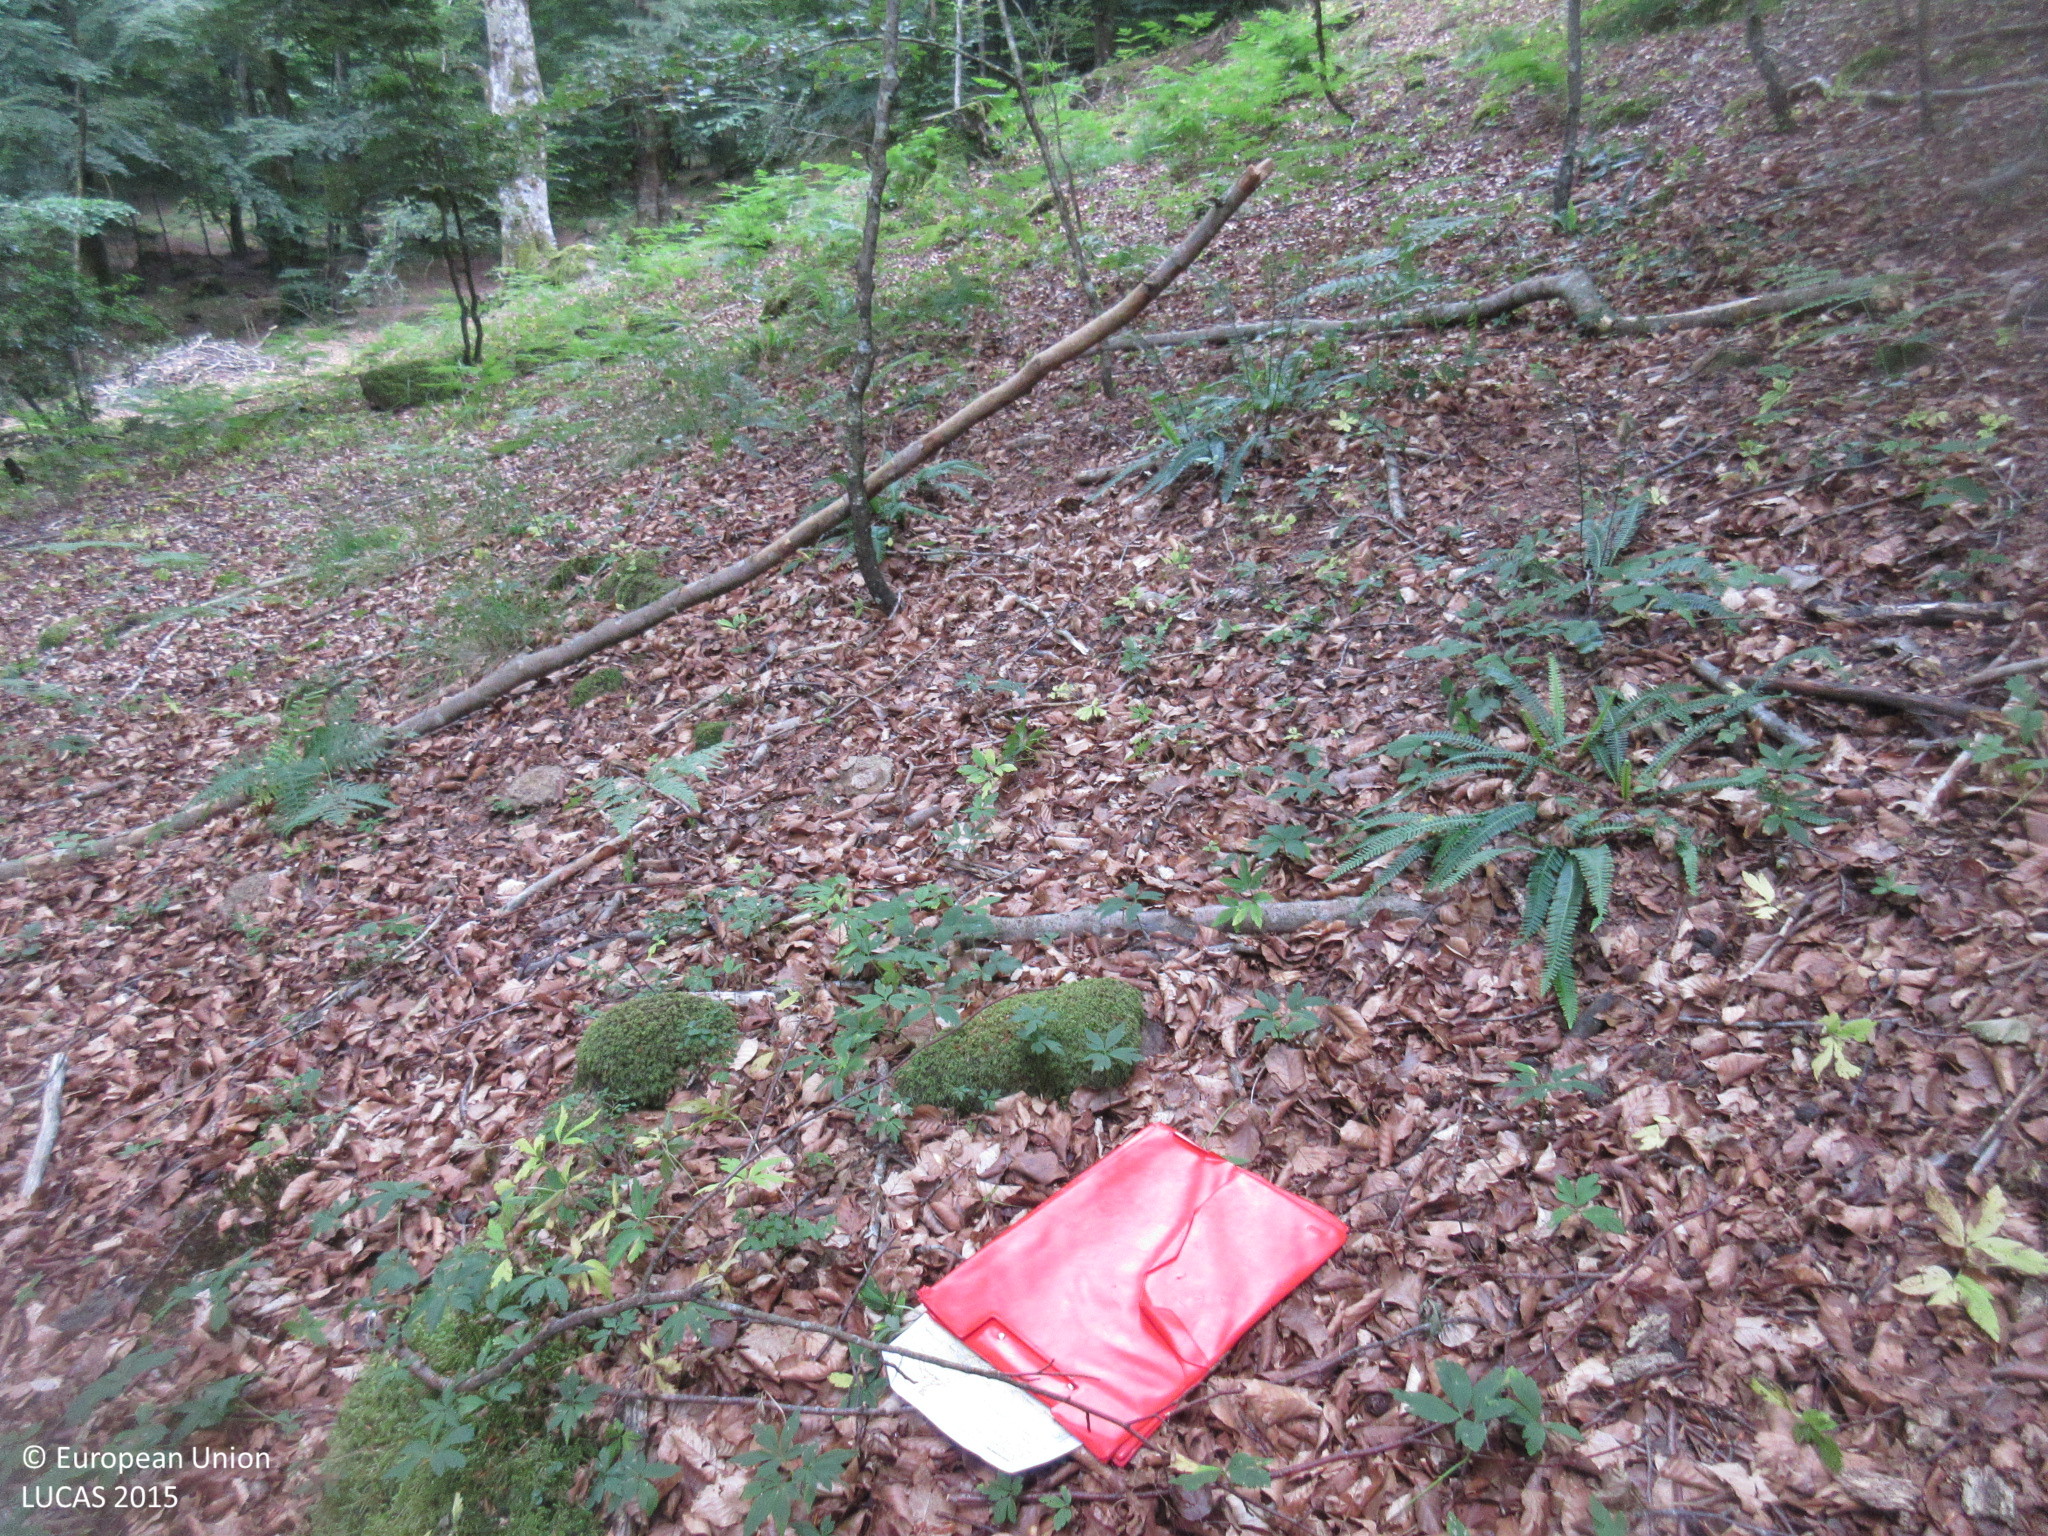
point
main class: Woodland
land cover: Broadleaved woodland
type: beech forest
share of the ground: > 75 %
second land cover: Shrubland without tree cover
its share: < 10 %
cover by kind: broadleaved forest trees 100 %
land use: Forestry
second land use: Agriculture (excluding fallow land and kitchen gardens)
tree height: > 5 m
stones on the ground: 10 - 25 %
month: July
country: ES
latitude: 43.0763
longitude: -4.0634
